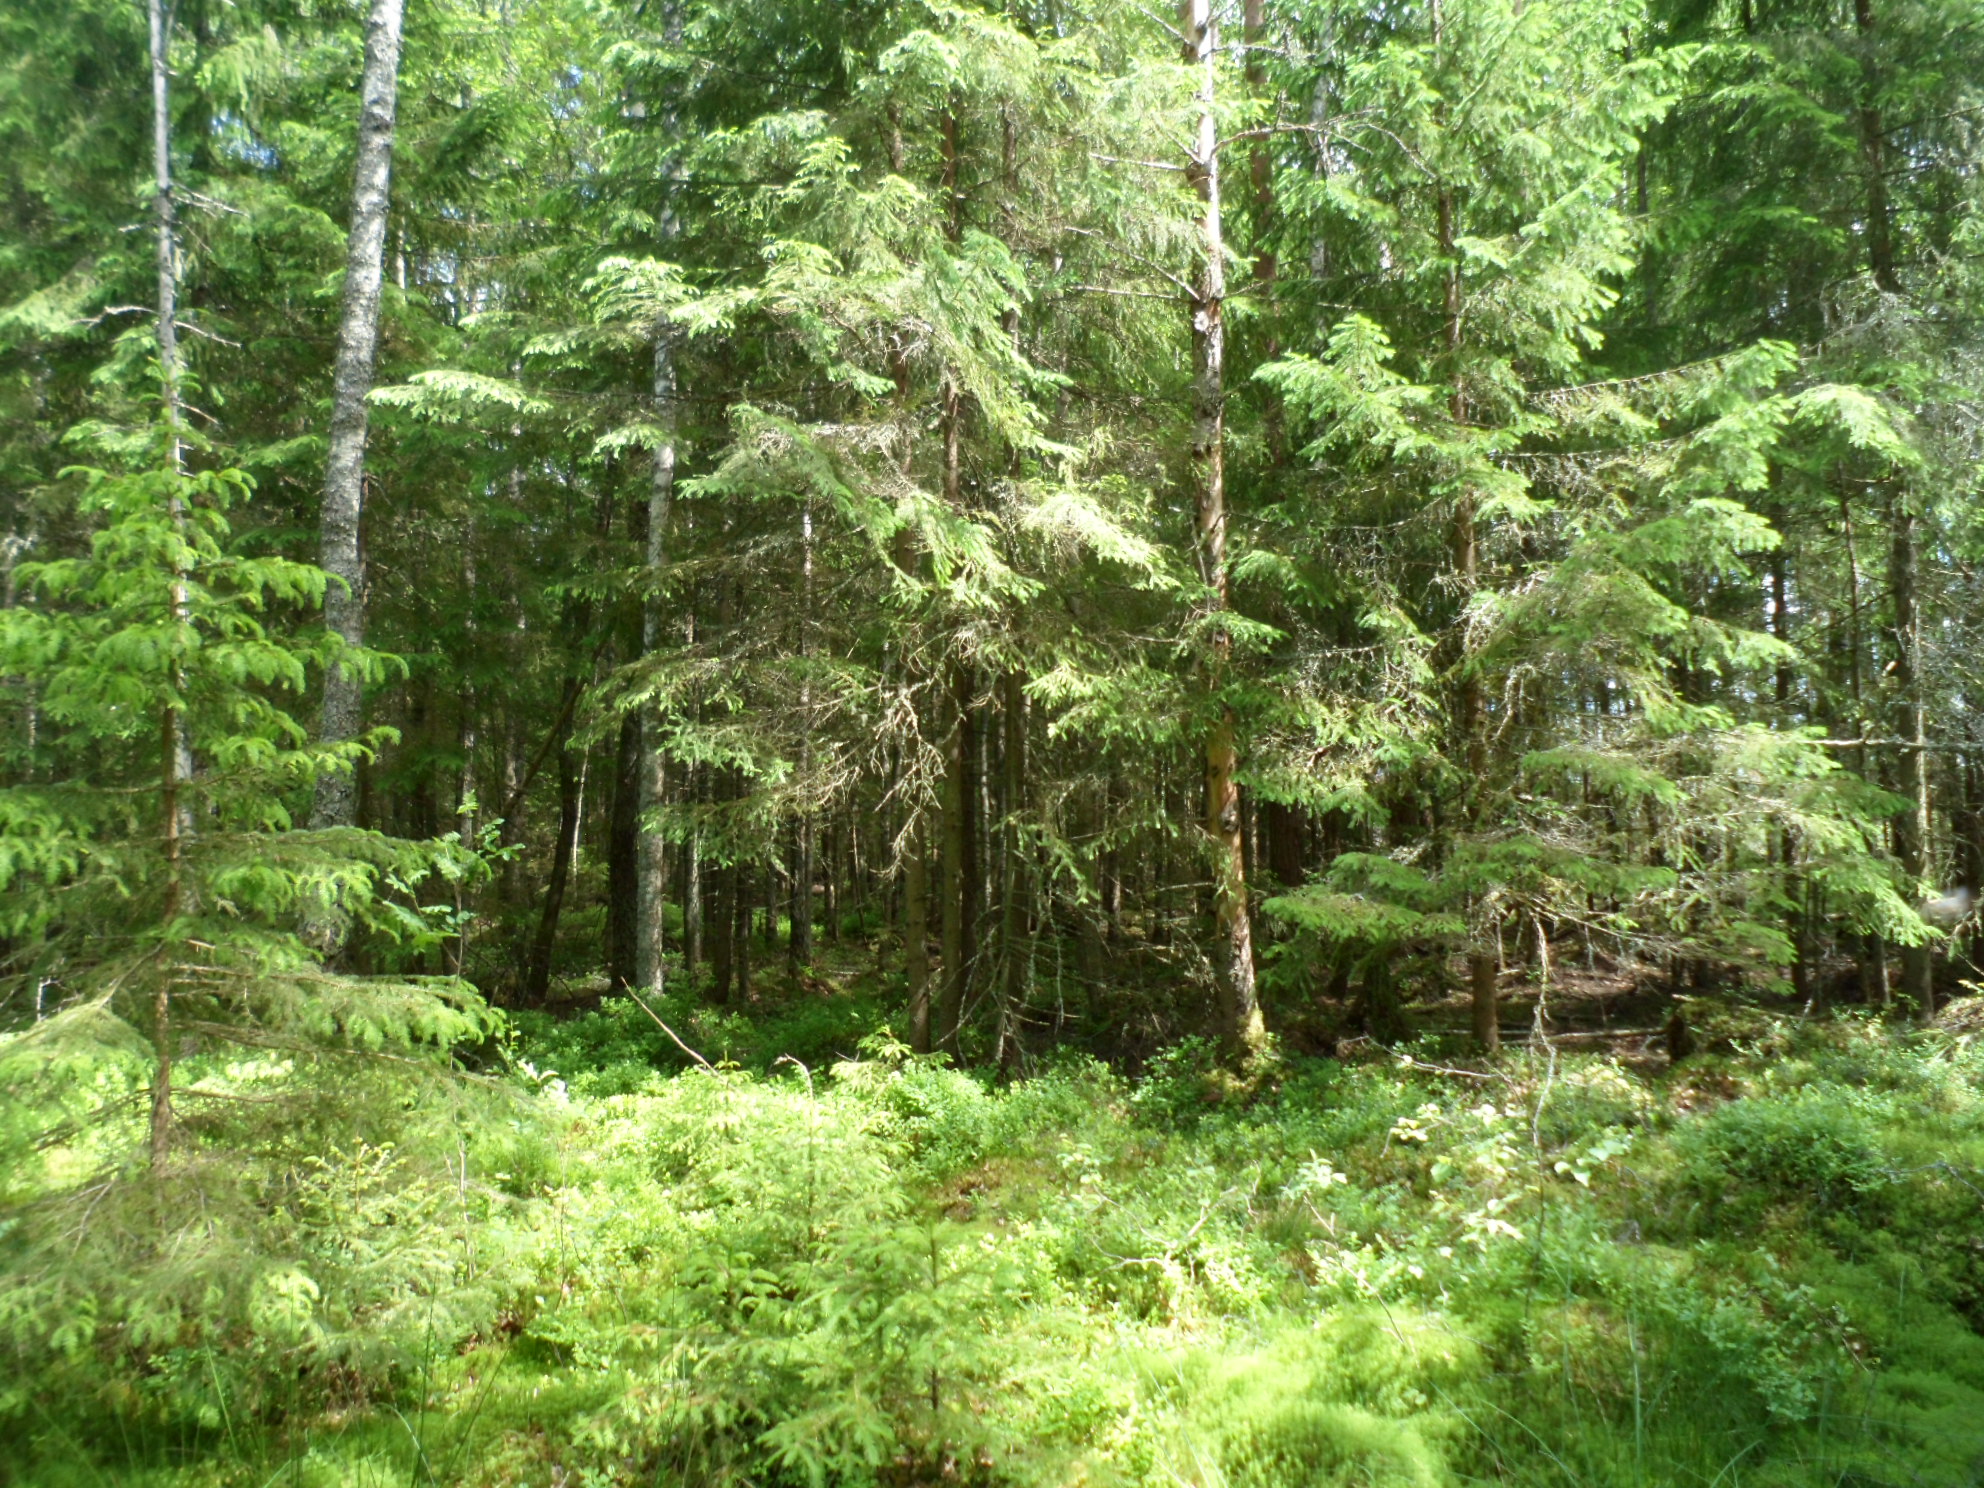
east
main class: Woodland
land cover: Spruce dominated mixed woodland
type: boreal forest
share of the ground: 50 - 75 %
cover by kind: coniferous forest trees 35 %, broadleaved forest trees 30 %, shrubs 25 %, herbaceous plants 5 %, lichens and mosses 5 %
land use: Forestry
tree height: > 5 m
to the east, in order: Spruce dominated mixed woodland; Spruce dominated coniferous woodland; Spruce dominated mixed woodland; Tracks; Pine dominated mixed woodland; Tracks; Broadleaved woodland; Spruce dominated mixed woodland
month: June
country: SE
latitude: 57.0510
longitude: 14.3320
